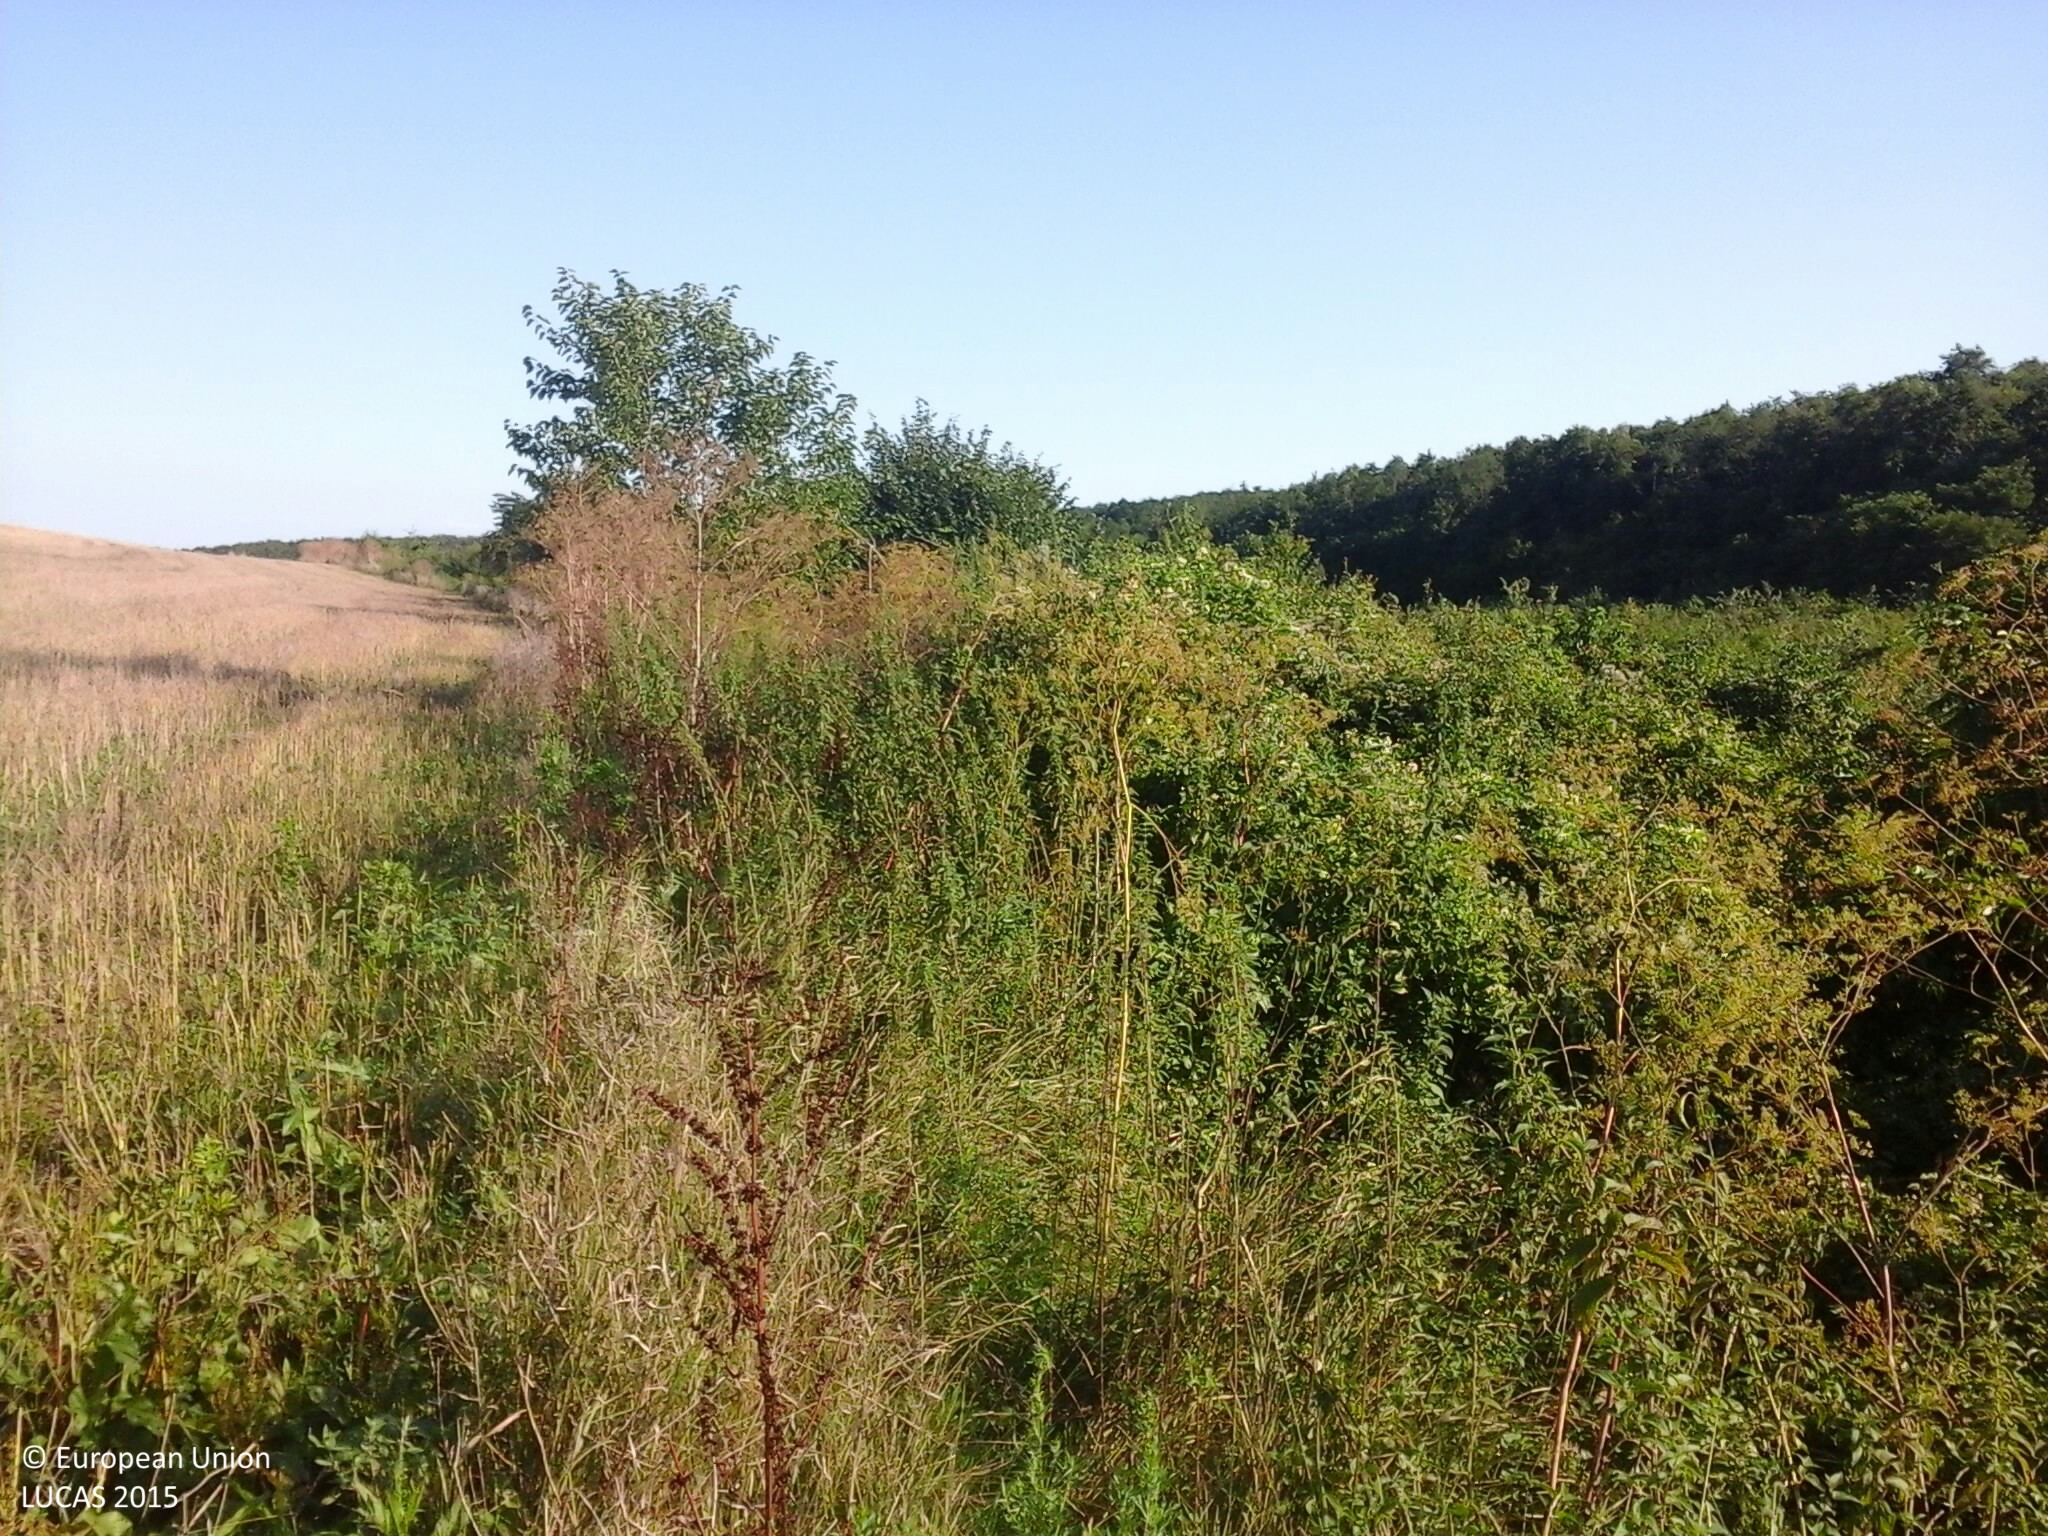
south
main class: Shrubland
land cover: Shrubland with sparse tree cover
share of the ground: > 75 %
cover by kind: shrubs 95 %, broadleaved forest trees 5 %
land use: Semi-natural and natural areas not in use
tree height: < 5 m
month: July
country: HU
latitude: 46.5965
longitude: 17.7208
